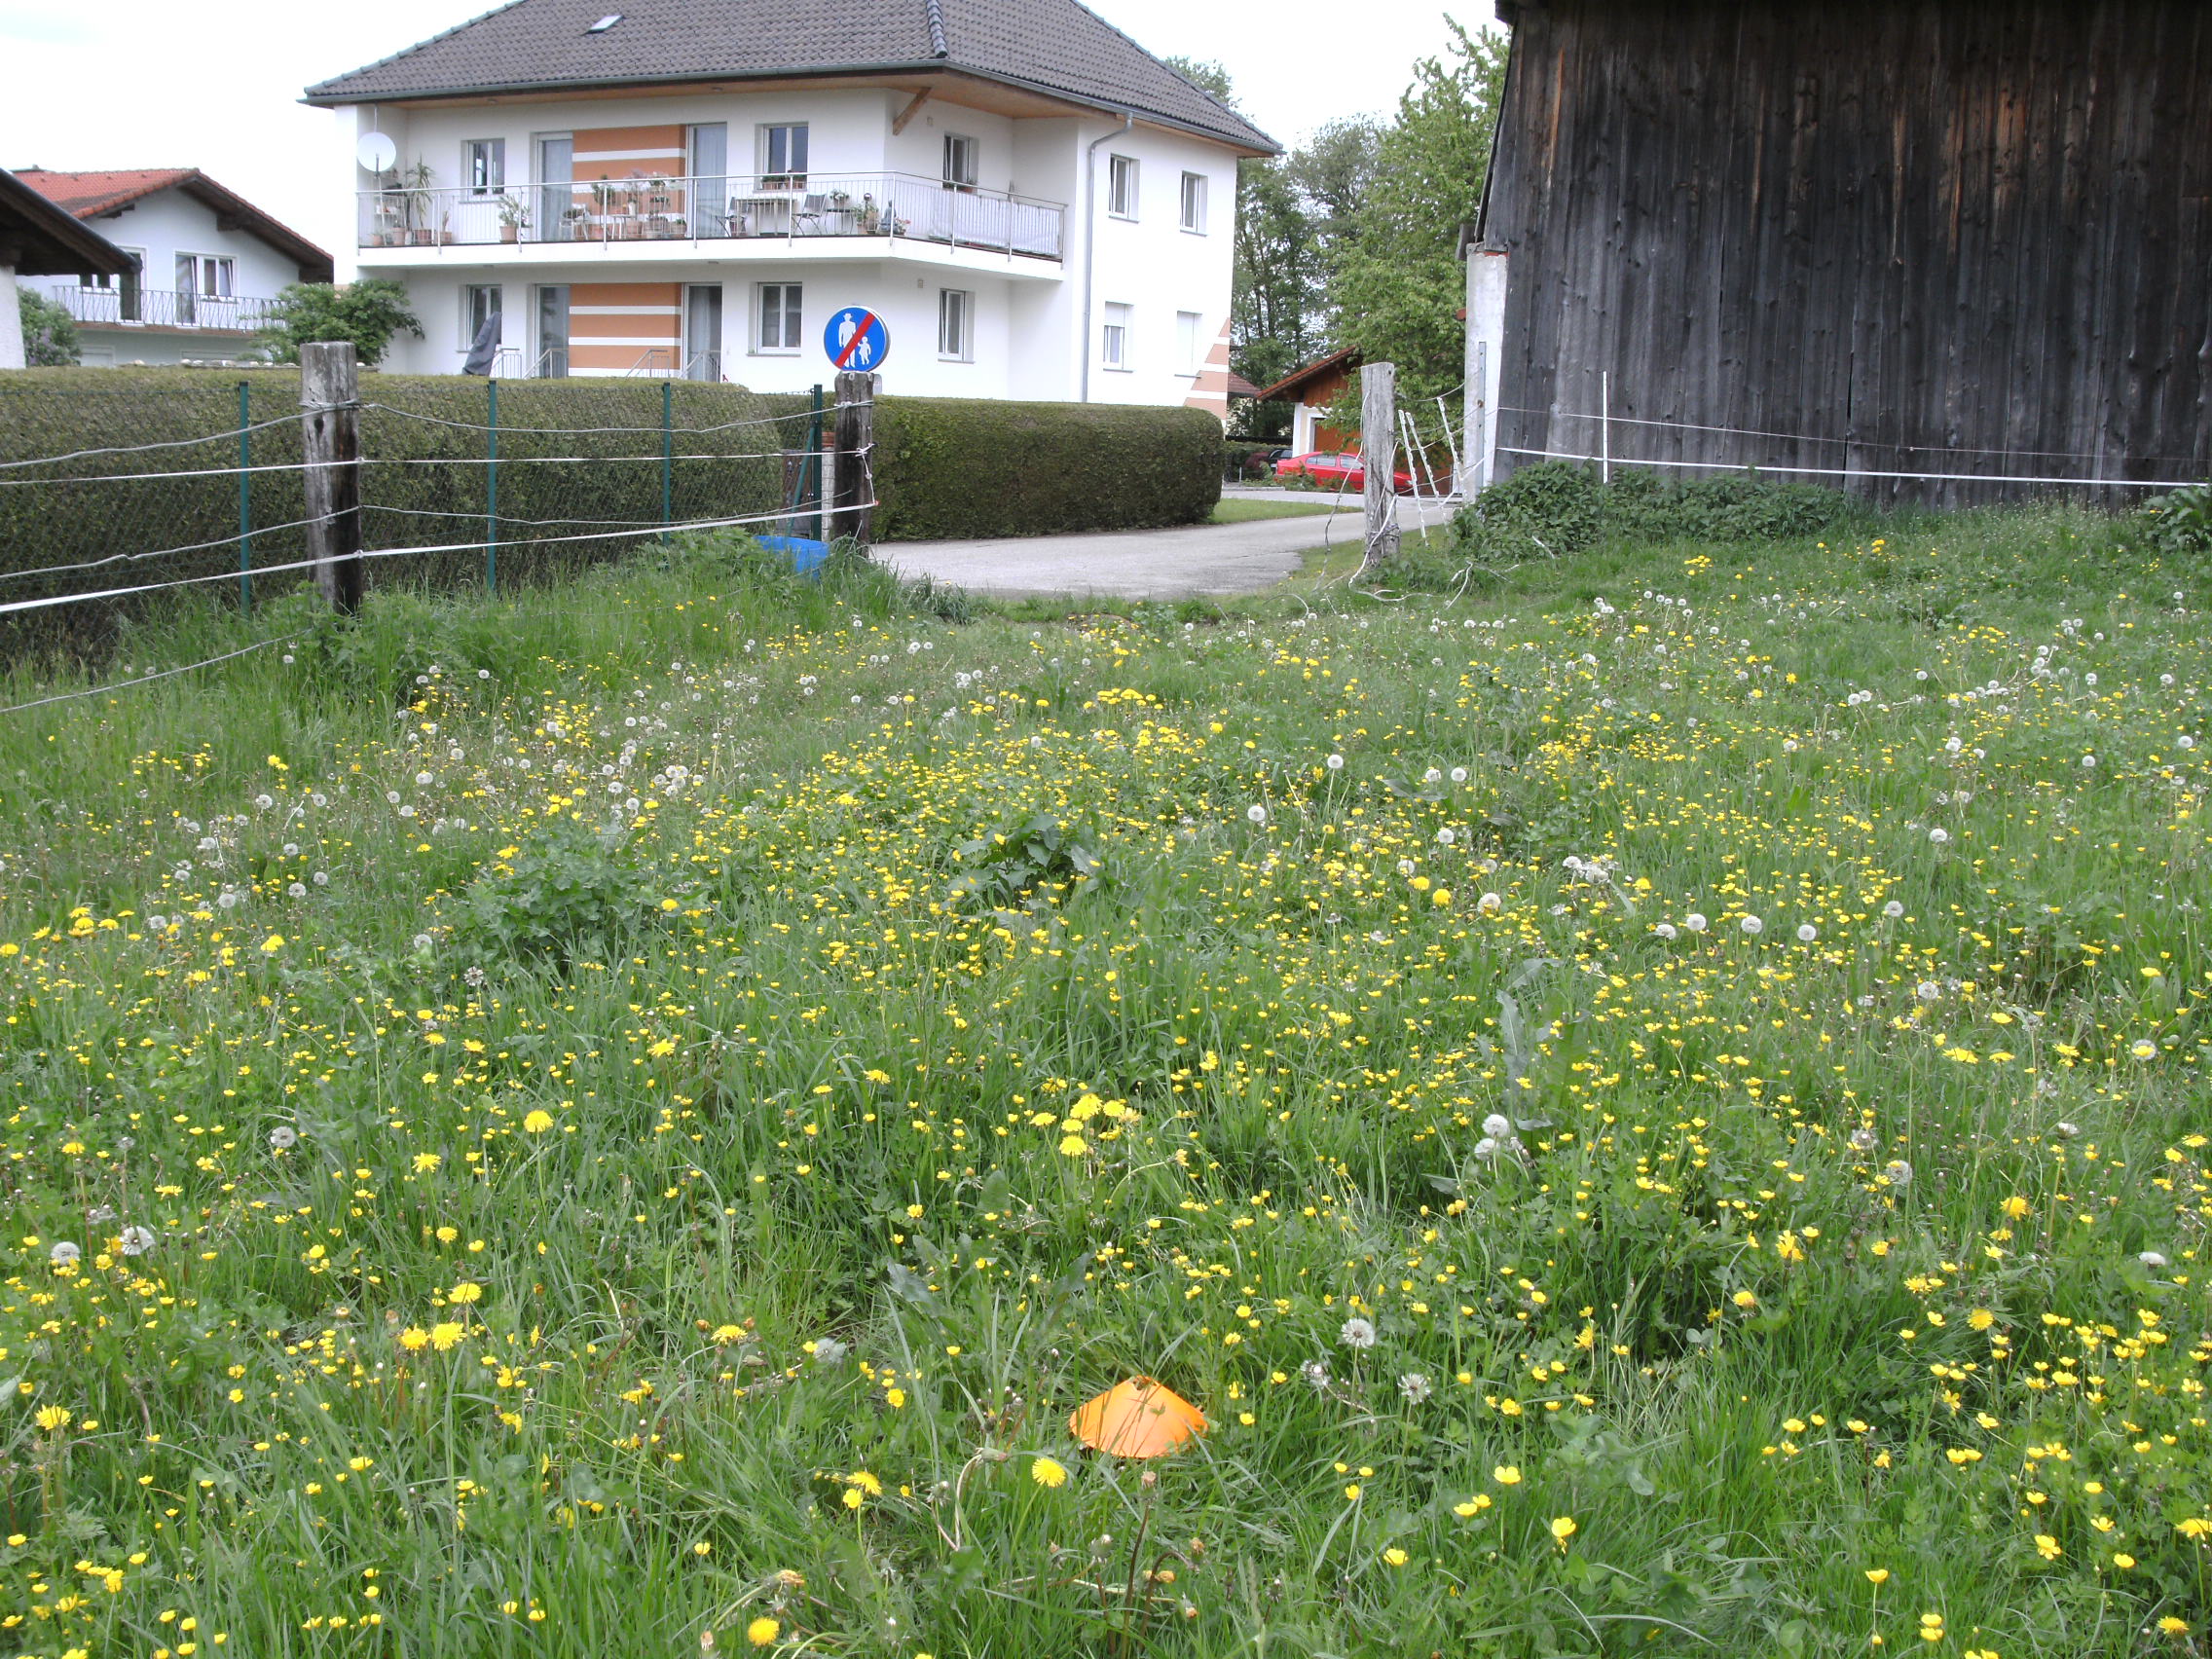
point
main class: Grassland
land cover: Grassland without tree/shrub cover
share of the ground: > 75 %
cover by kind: herbaceous plants 100 %
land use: Agriculture (excluding fallow land and kitchen gardens)
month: May
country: AT
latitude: 48.3345
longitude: 13.3583
